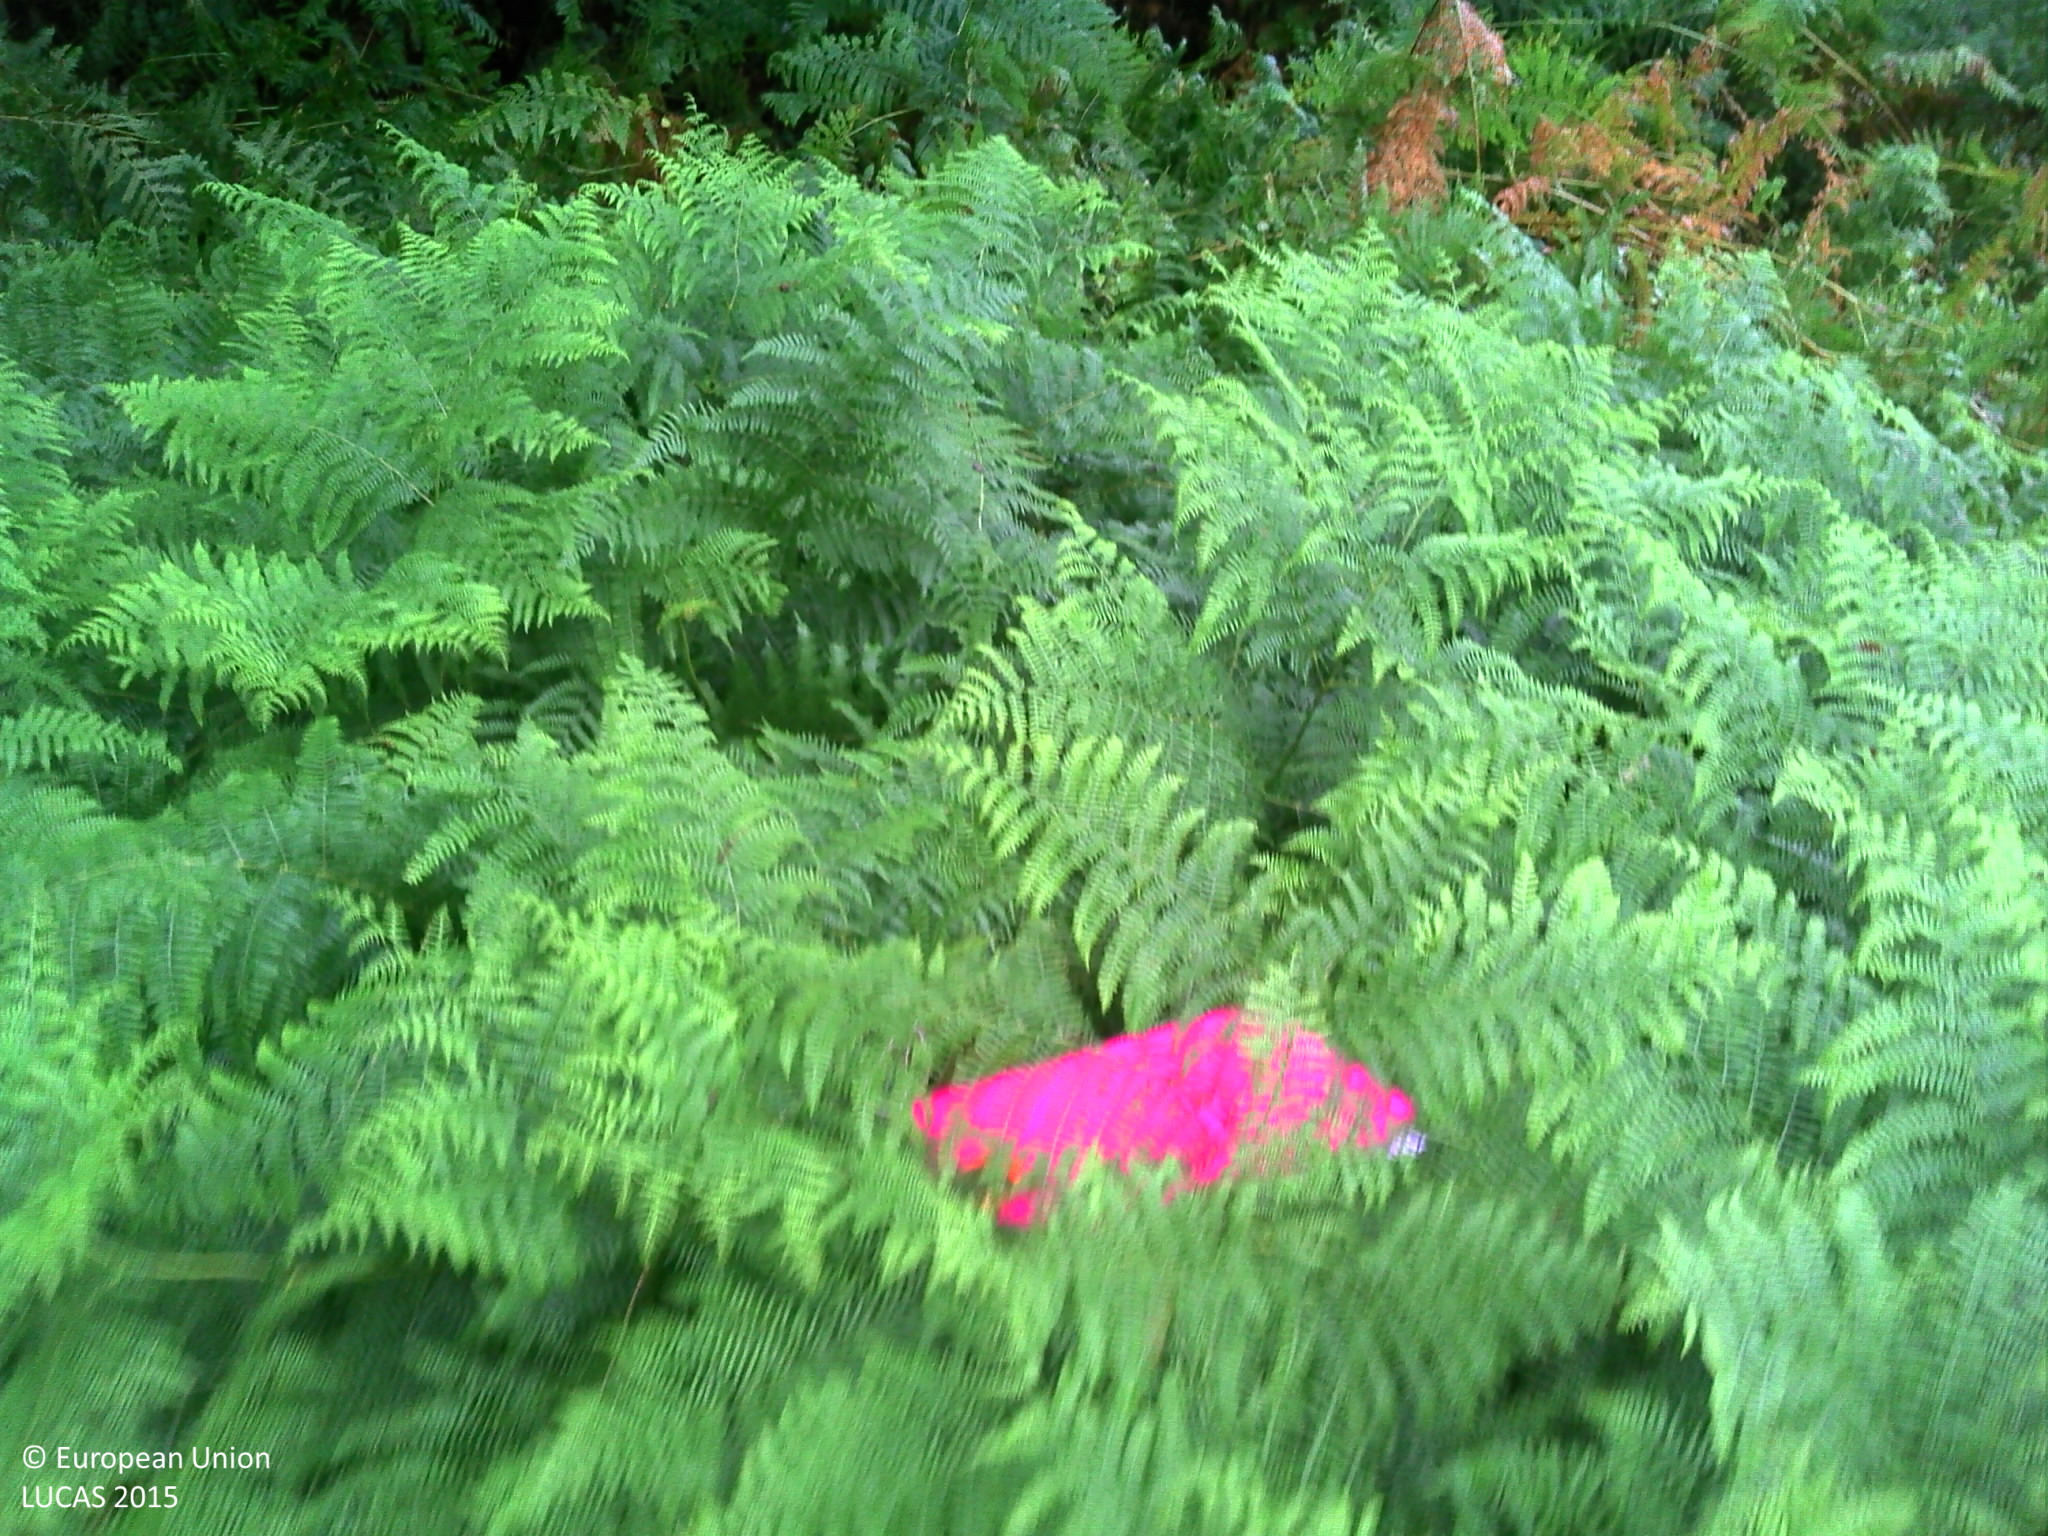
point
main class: Shrubland
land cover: Shrubland without tree cover
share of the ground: > 75 %
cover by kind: shrubs 100 %
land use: Semi-natural and natural areas not in use
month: August
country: FR
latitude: 45.9899
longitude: 1.2240
